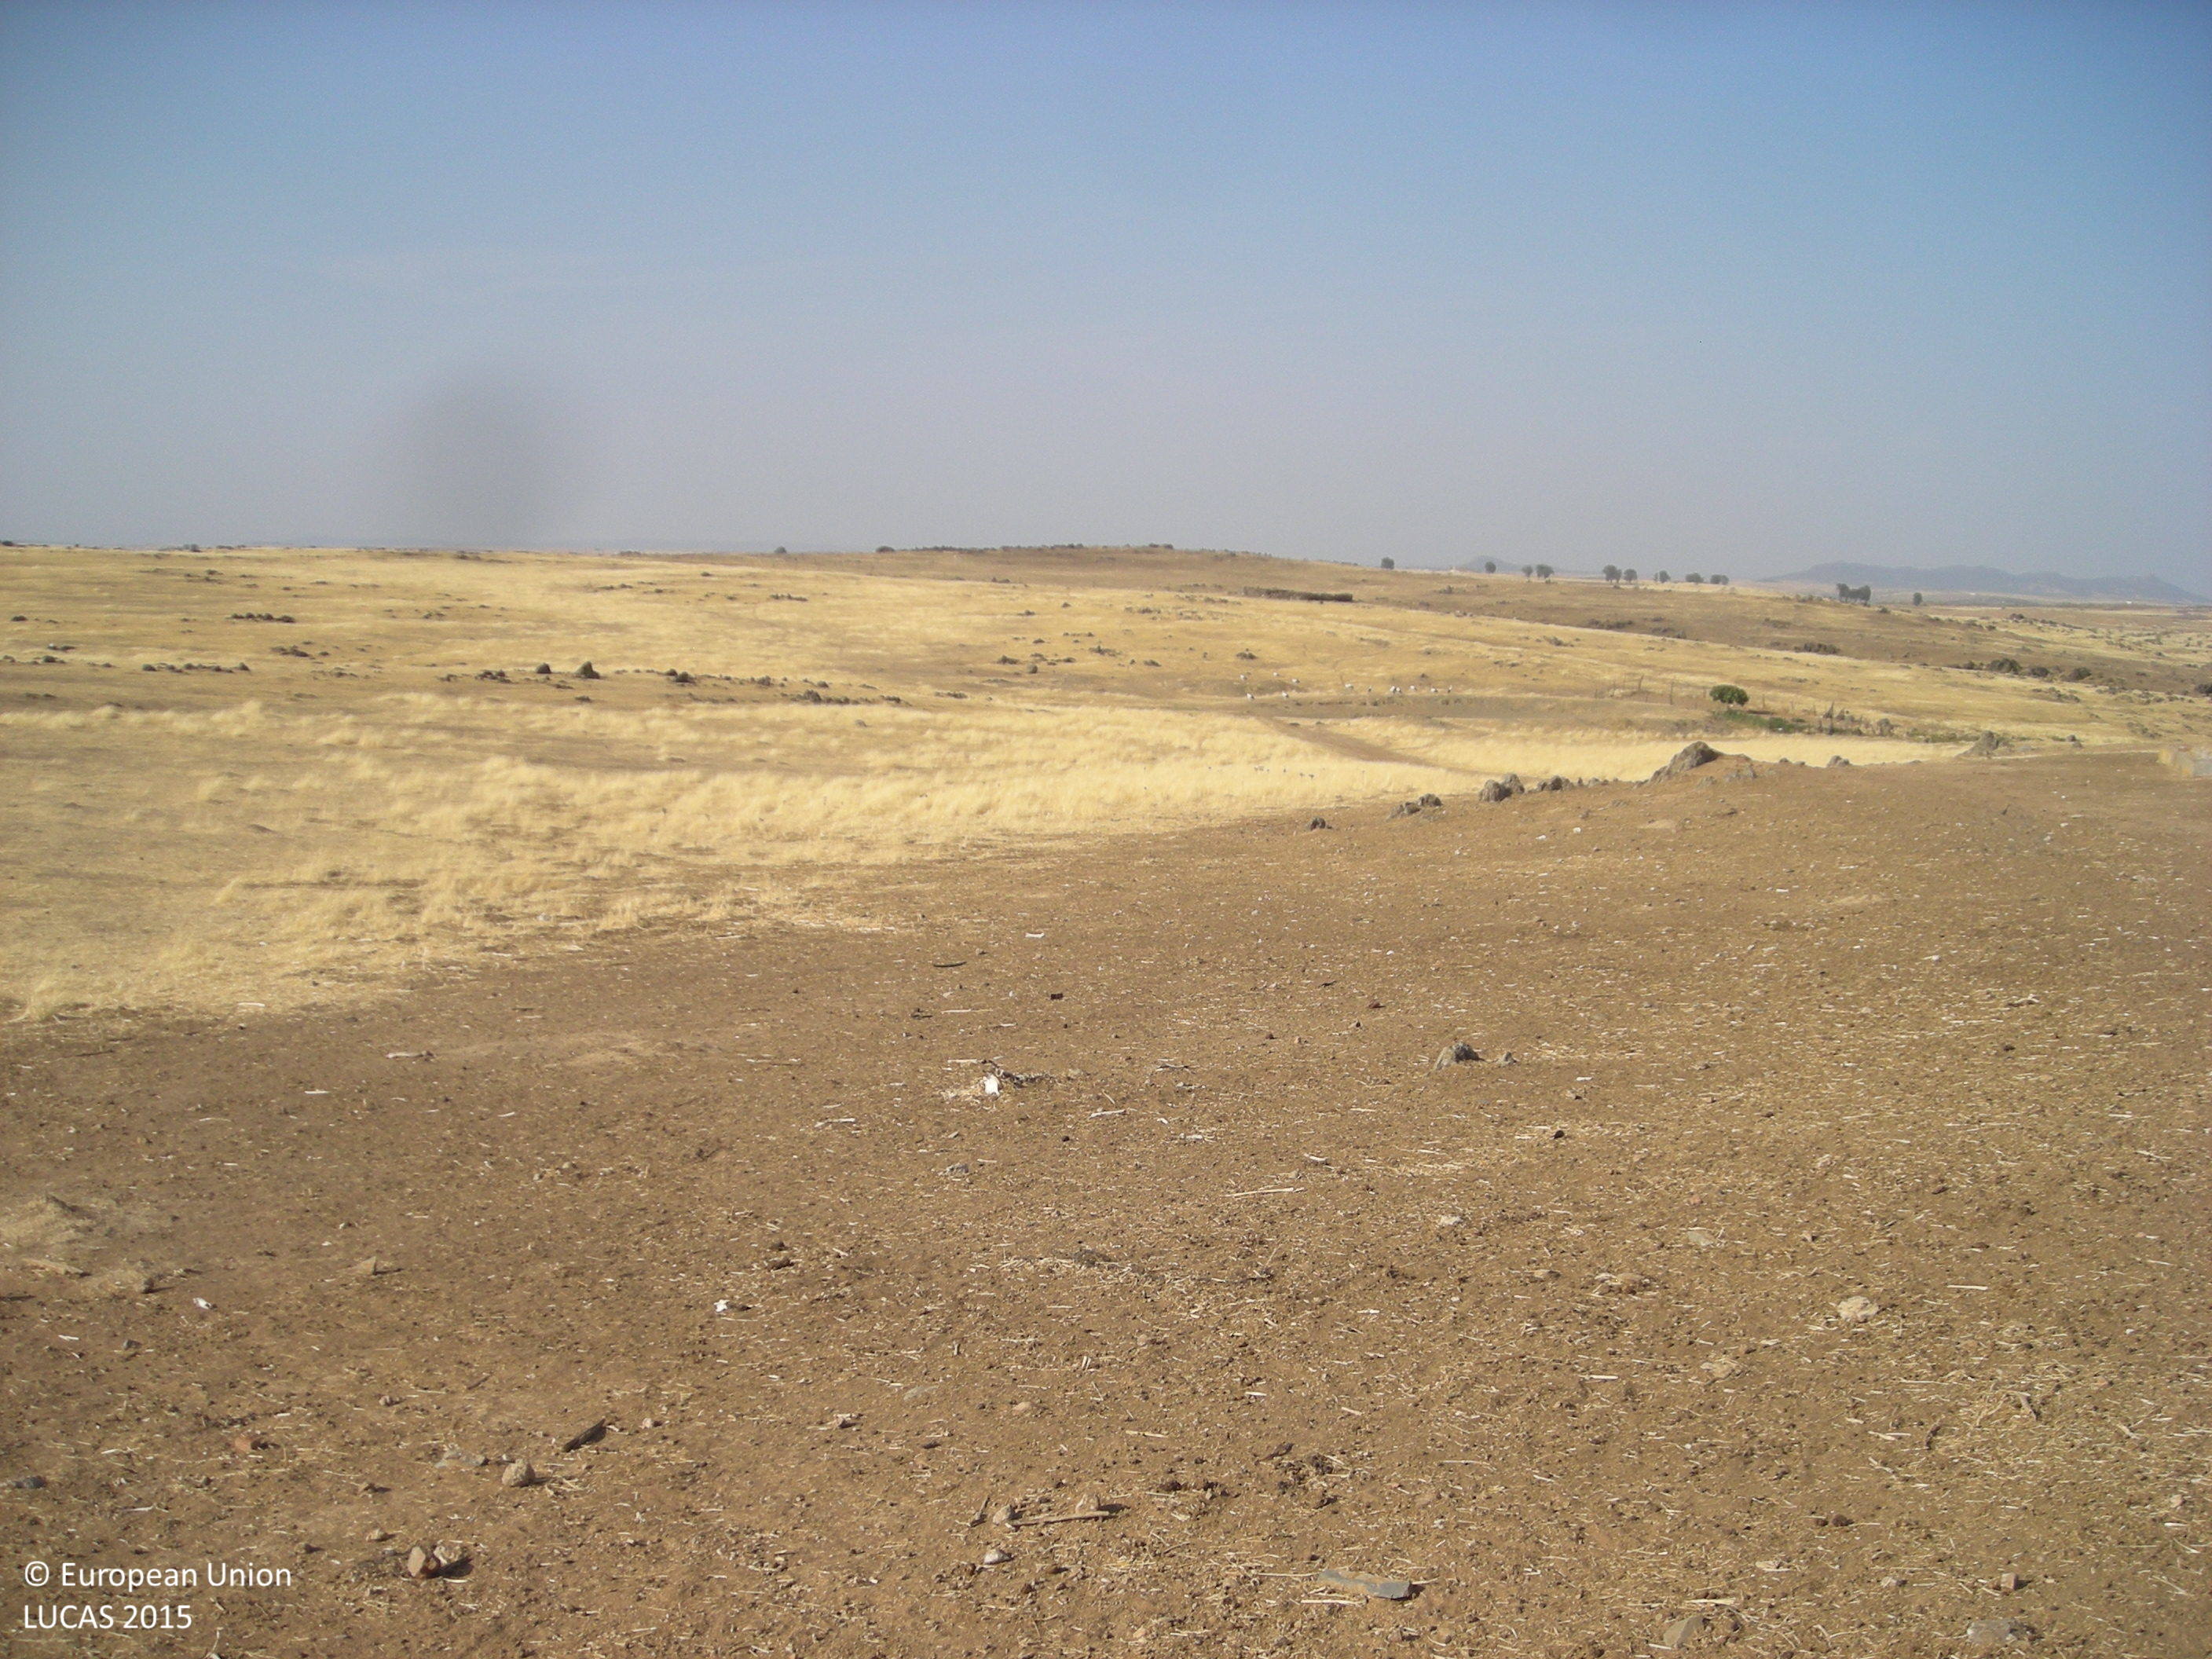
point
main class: Grassland
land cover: Grassland without tree/shrub cover
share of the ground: > 75 %
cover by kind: herbaceous plants 100 %
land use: Agriculture (excluding fallow land and kitchen gardens)
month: July
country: ES
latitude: 38.8837
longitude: -5.4772
